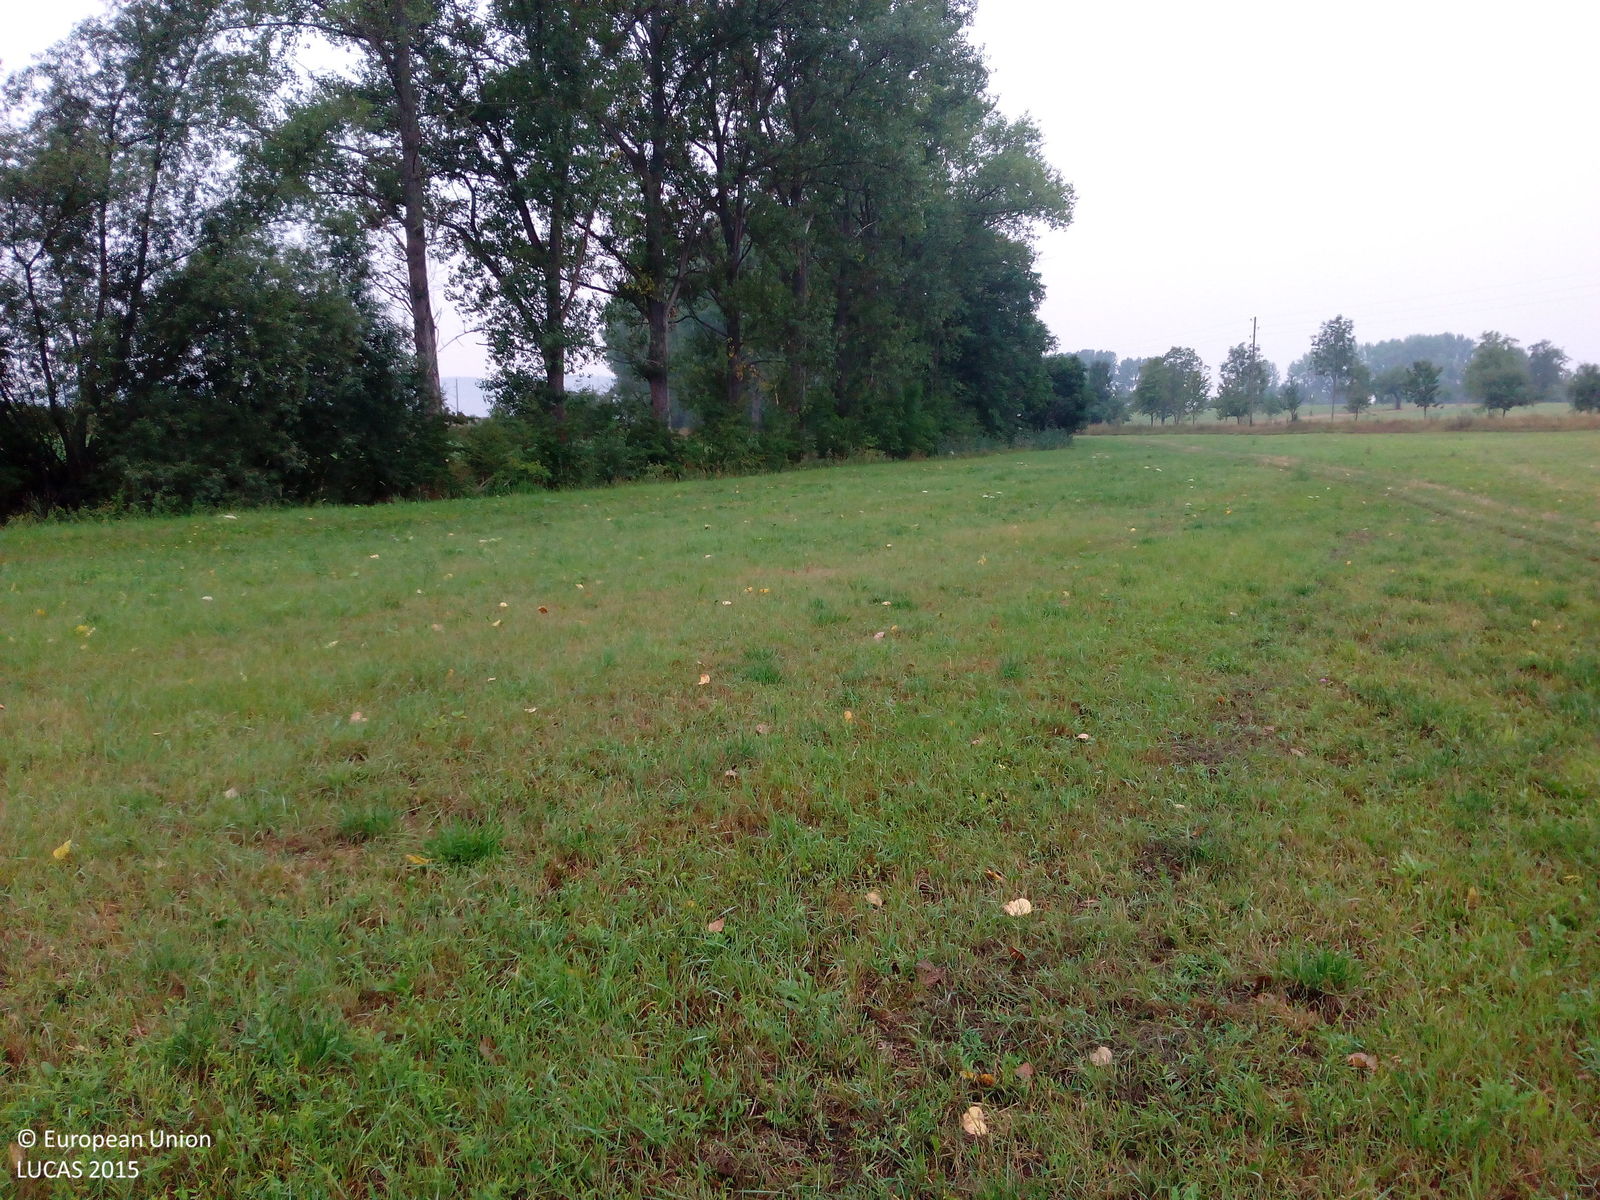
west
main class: Grassland
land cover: Grassland without tree/shrub cover
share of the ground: > 75 %
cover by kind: herbaceous plants 100 %
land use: Agriculture (excluding fallow land and kitchen gardens)
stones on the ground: 10 - 25 %
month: August
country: DE
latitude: 50.9184
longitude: 10.8390
